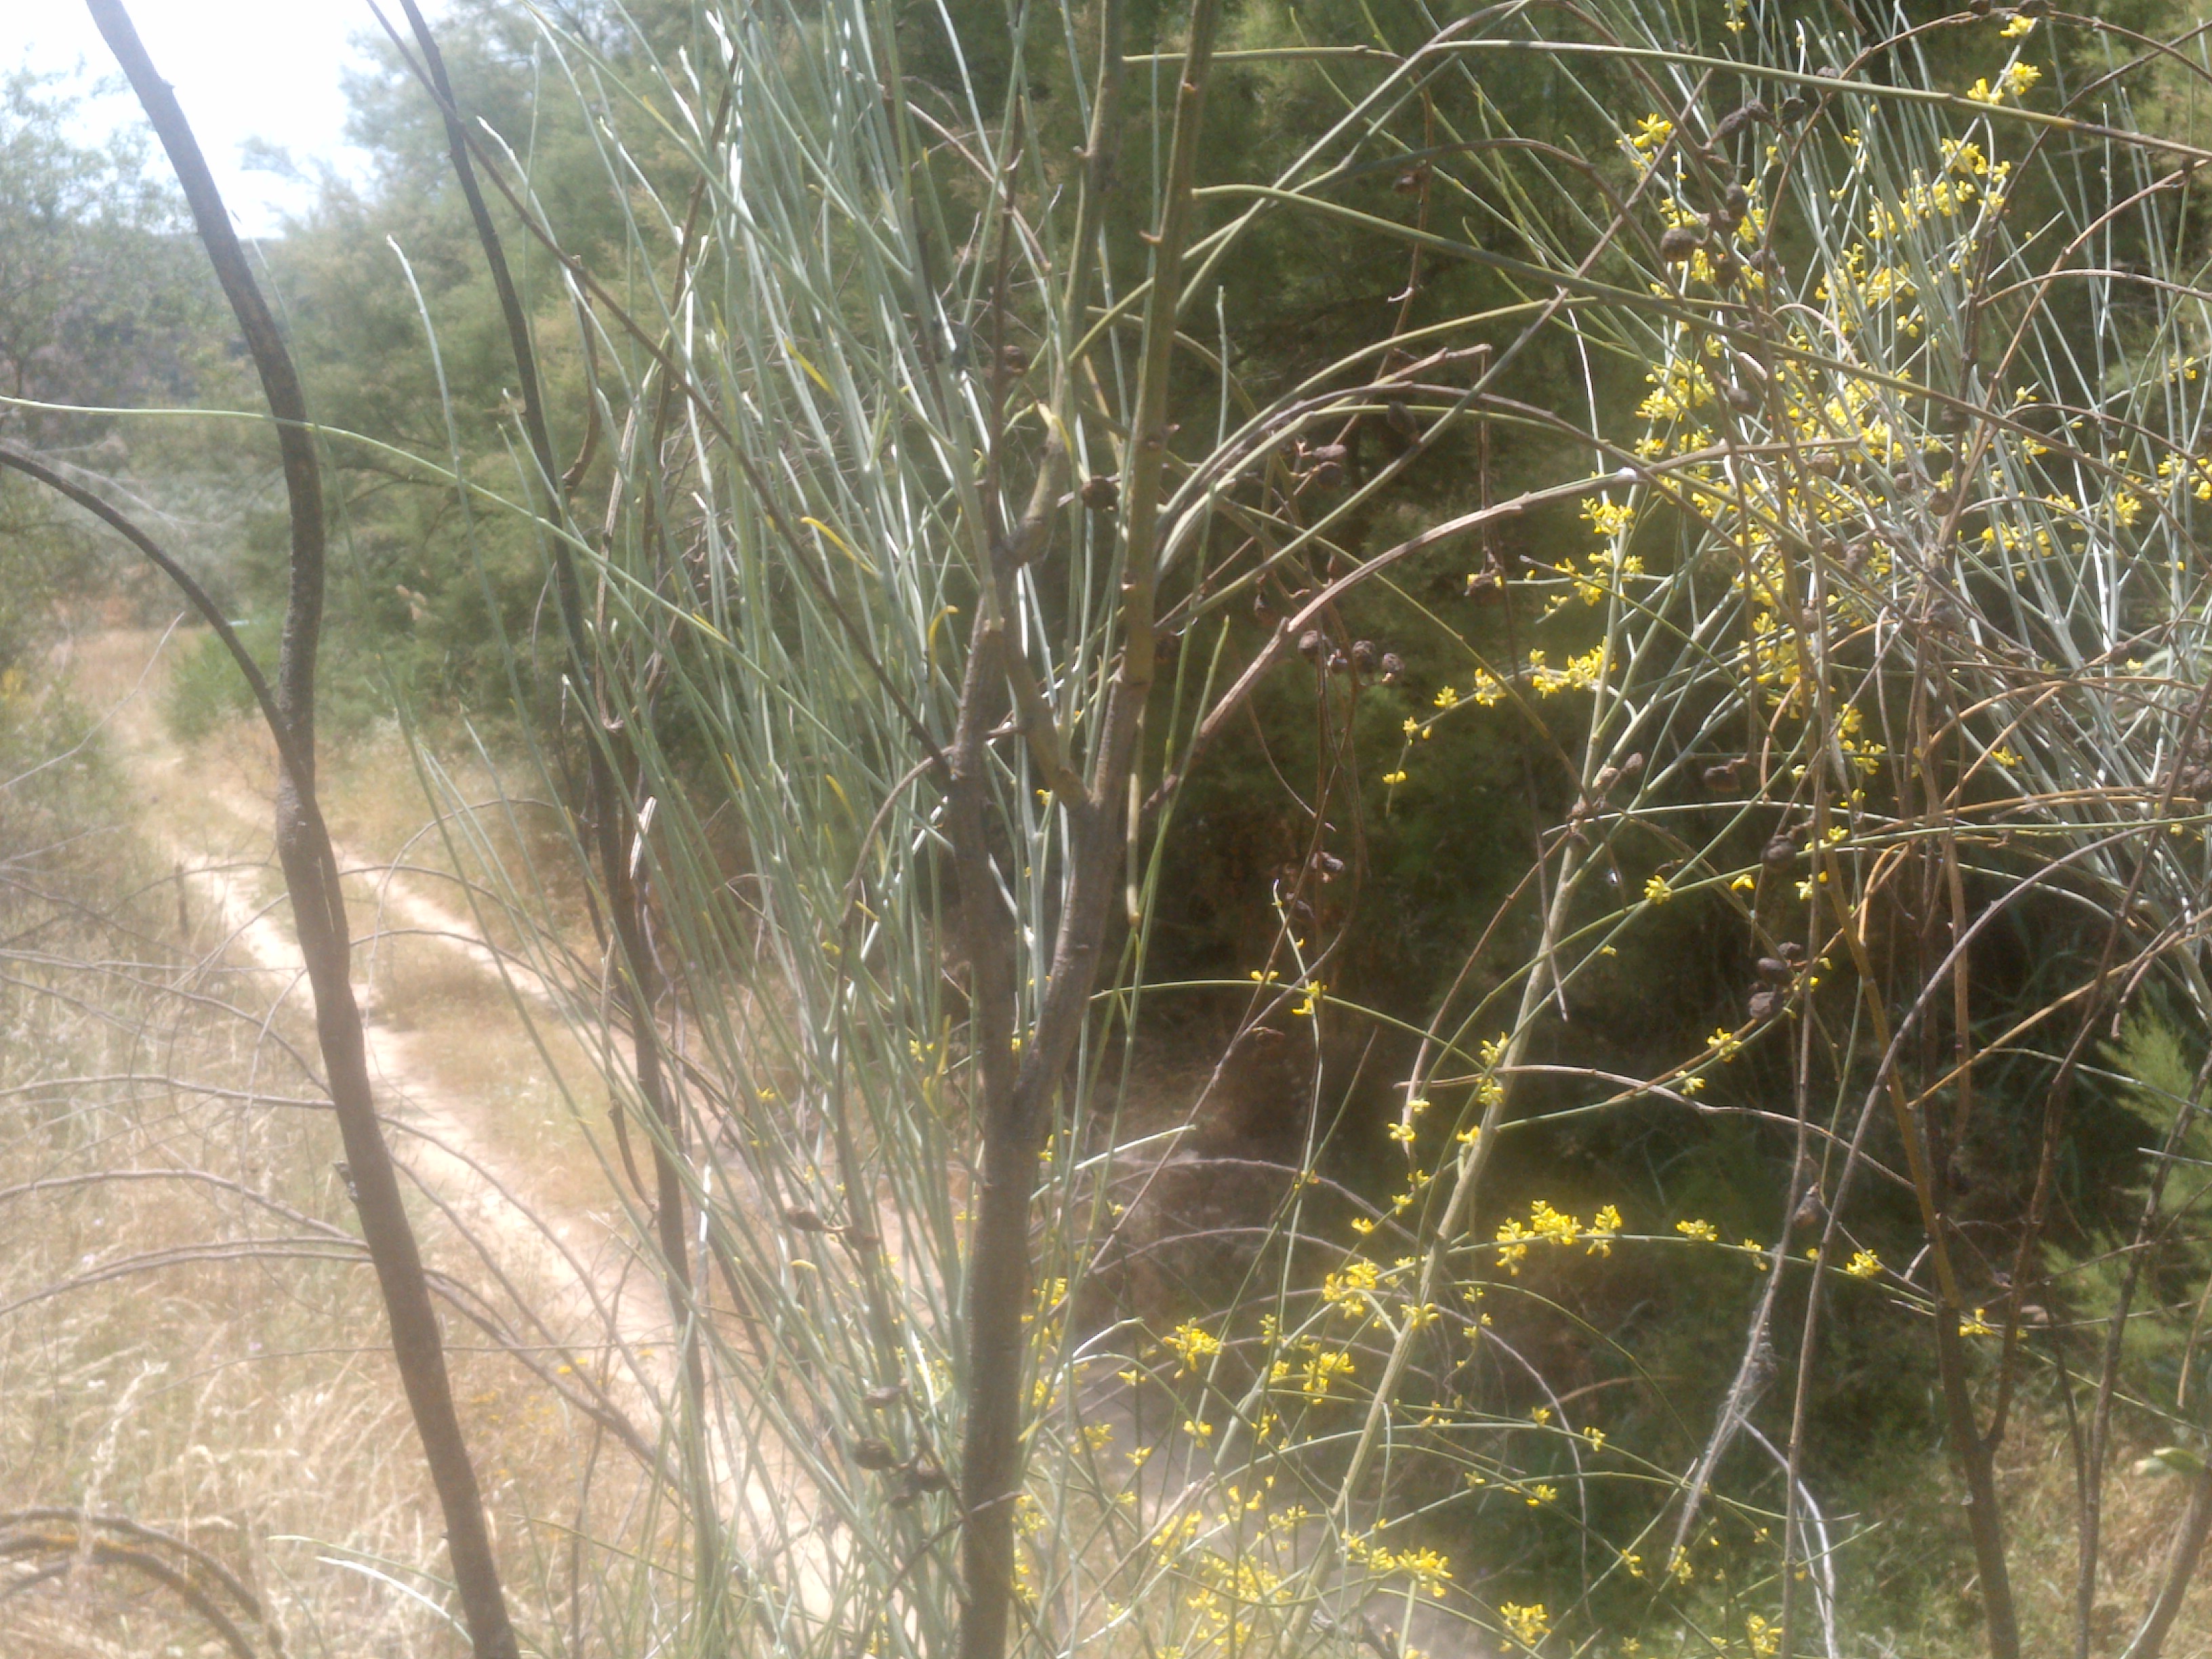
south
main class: Shrubland
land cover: Shrubland without tree cover
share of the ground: > 75 %
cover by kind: shrubs 80 %, herbaceous plants 10 %, unconsolidated bare surface 10 %
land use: Semi-natural and natural areas not in use
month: May
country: ES
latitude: 37.5035
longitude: -4.1974
